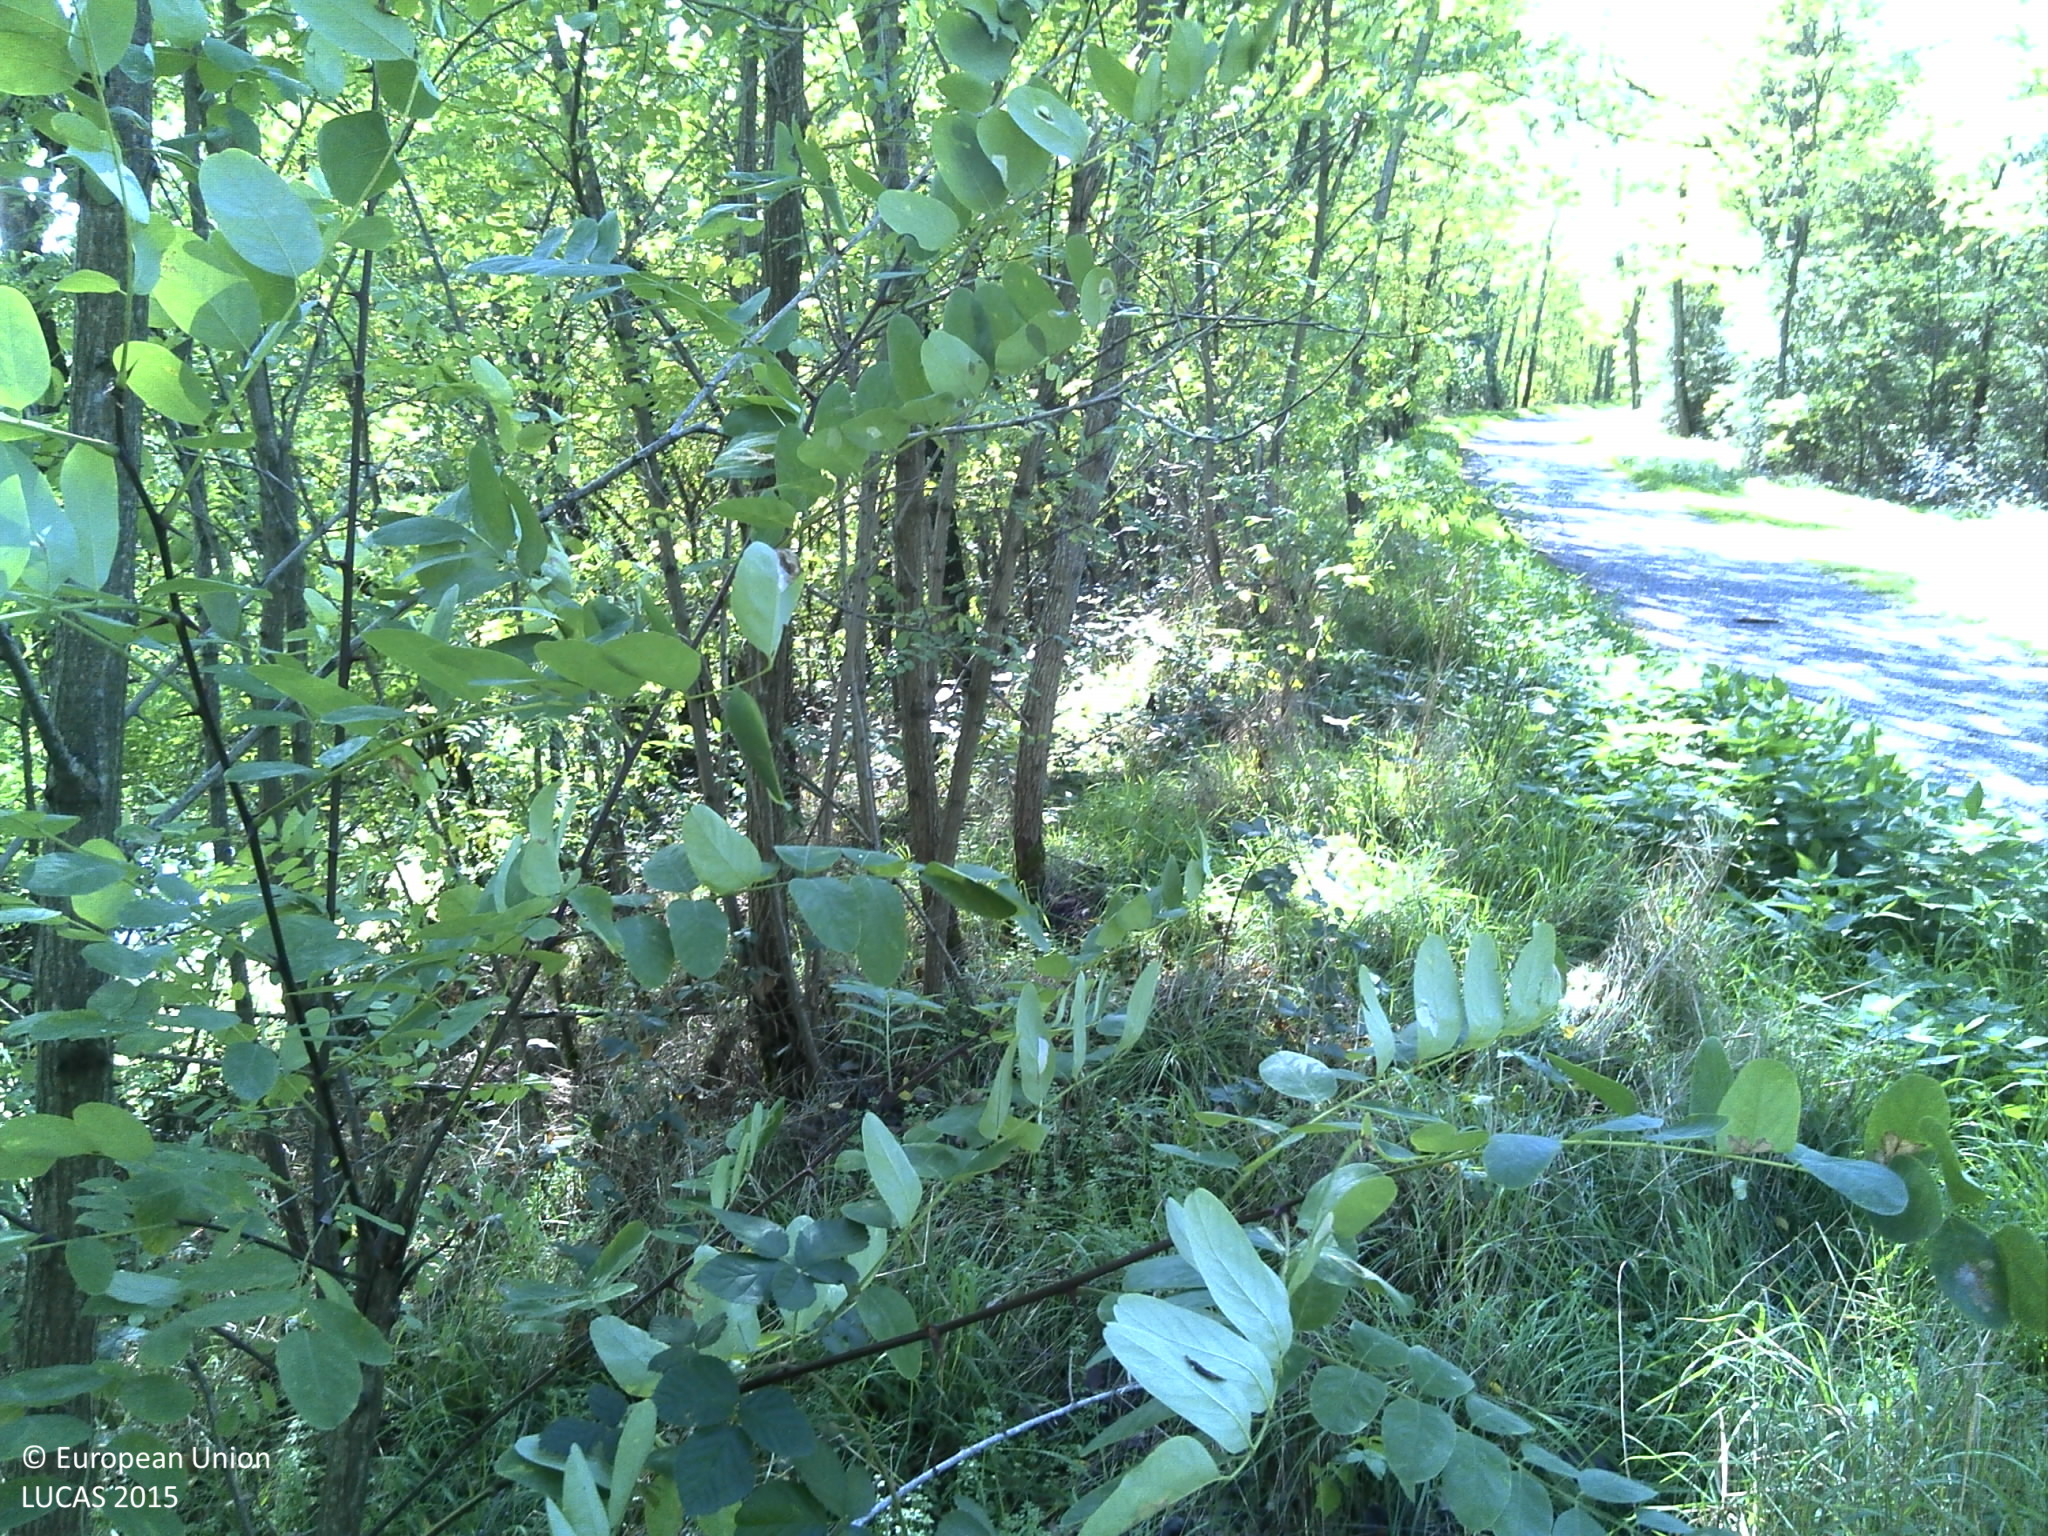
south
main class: Woodland
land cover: Broadleaved woodland
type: mesophytic deciduous forest
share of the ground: > 75 %
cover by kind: broadleaved forest trees 80 %, herbaceous plants 20 %
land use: Semi-natural and natural areas not in use
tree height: > 5 m
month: October
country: FR
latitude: 46.5835
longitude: 4.0623
